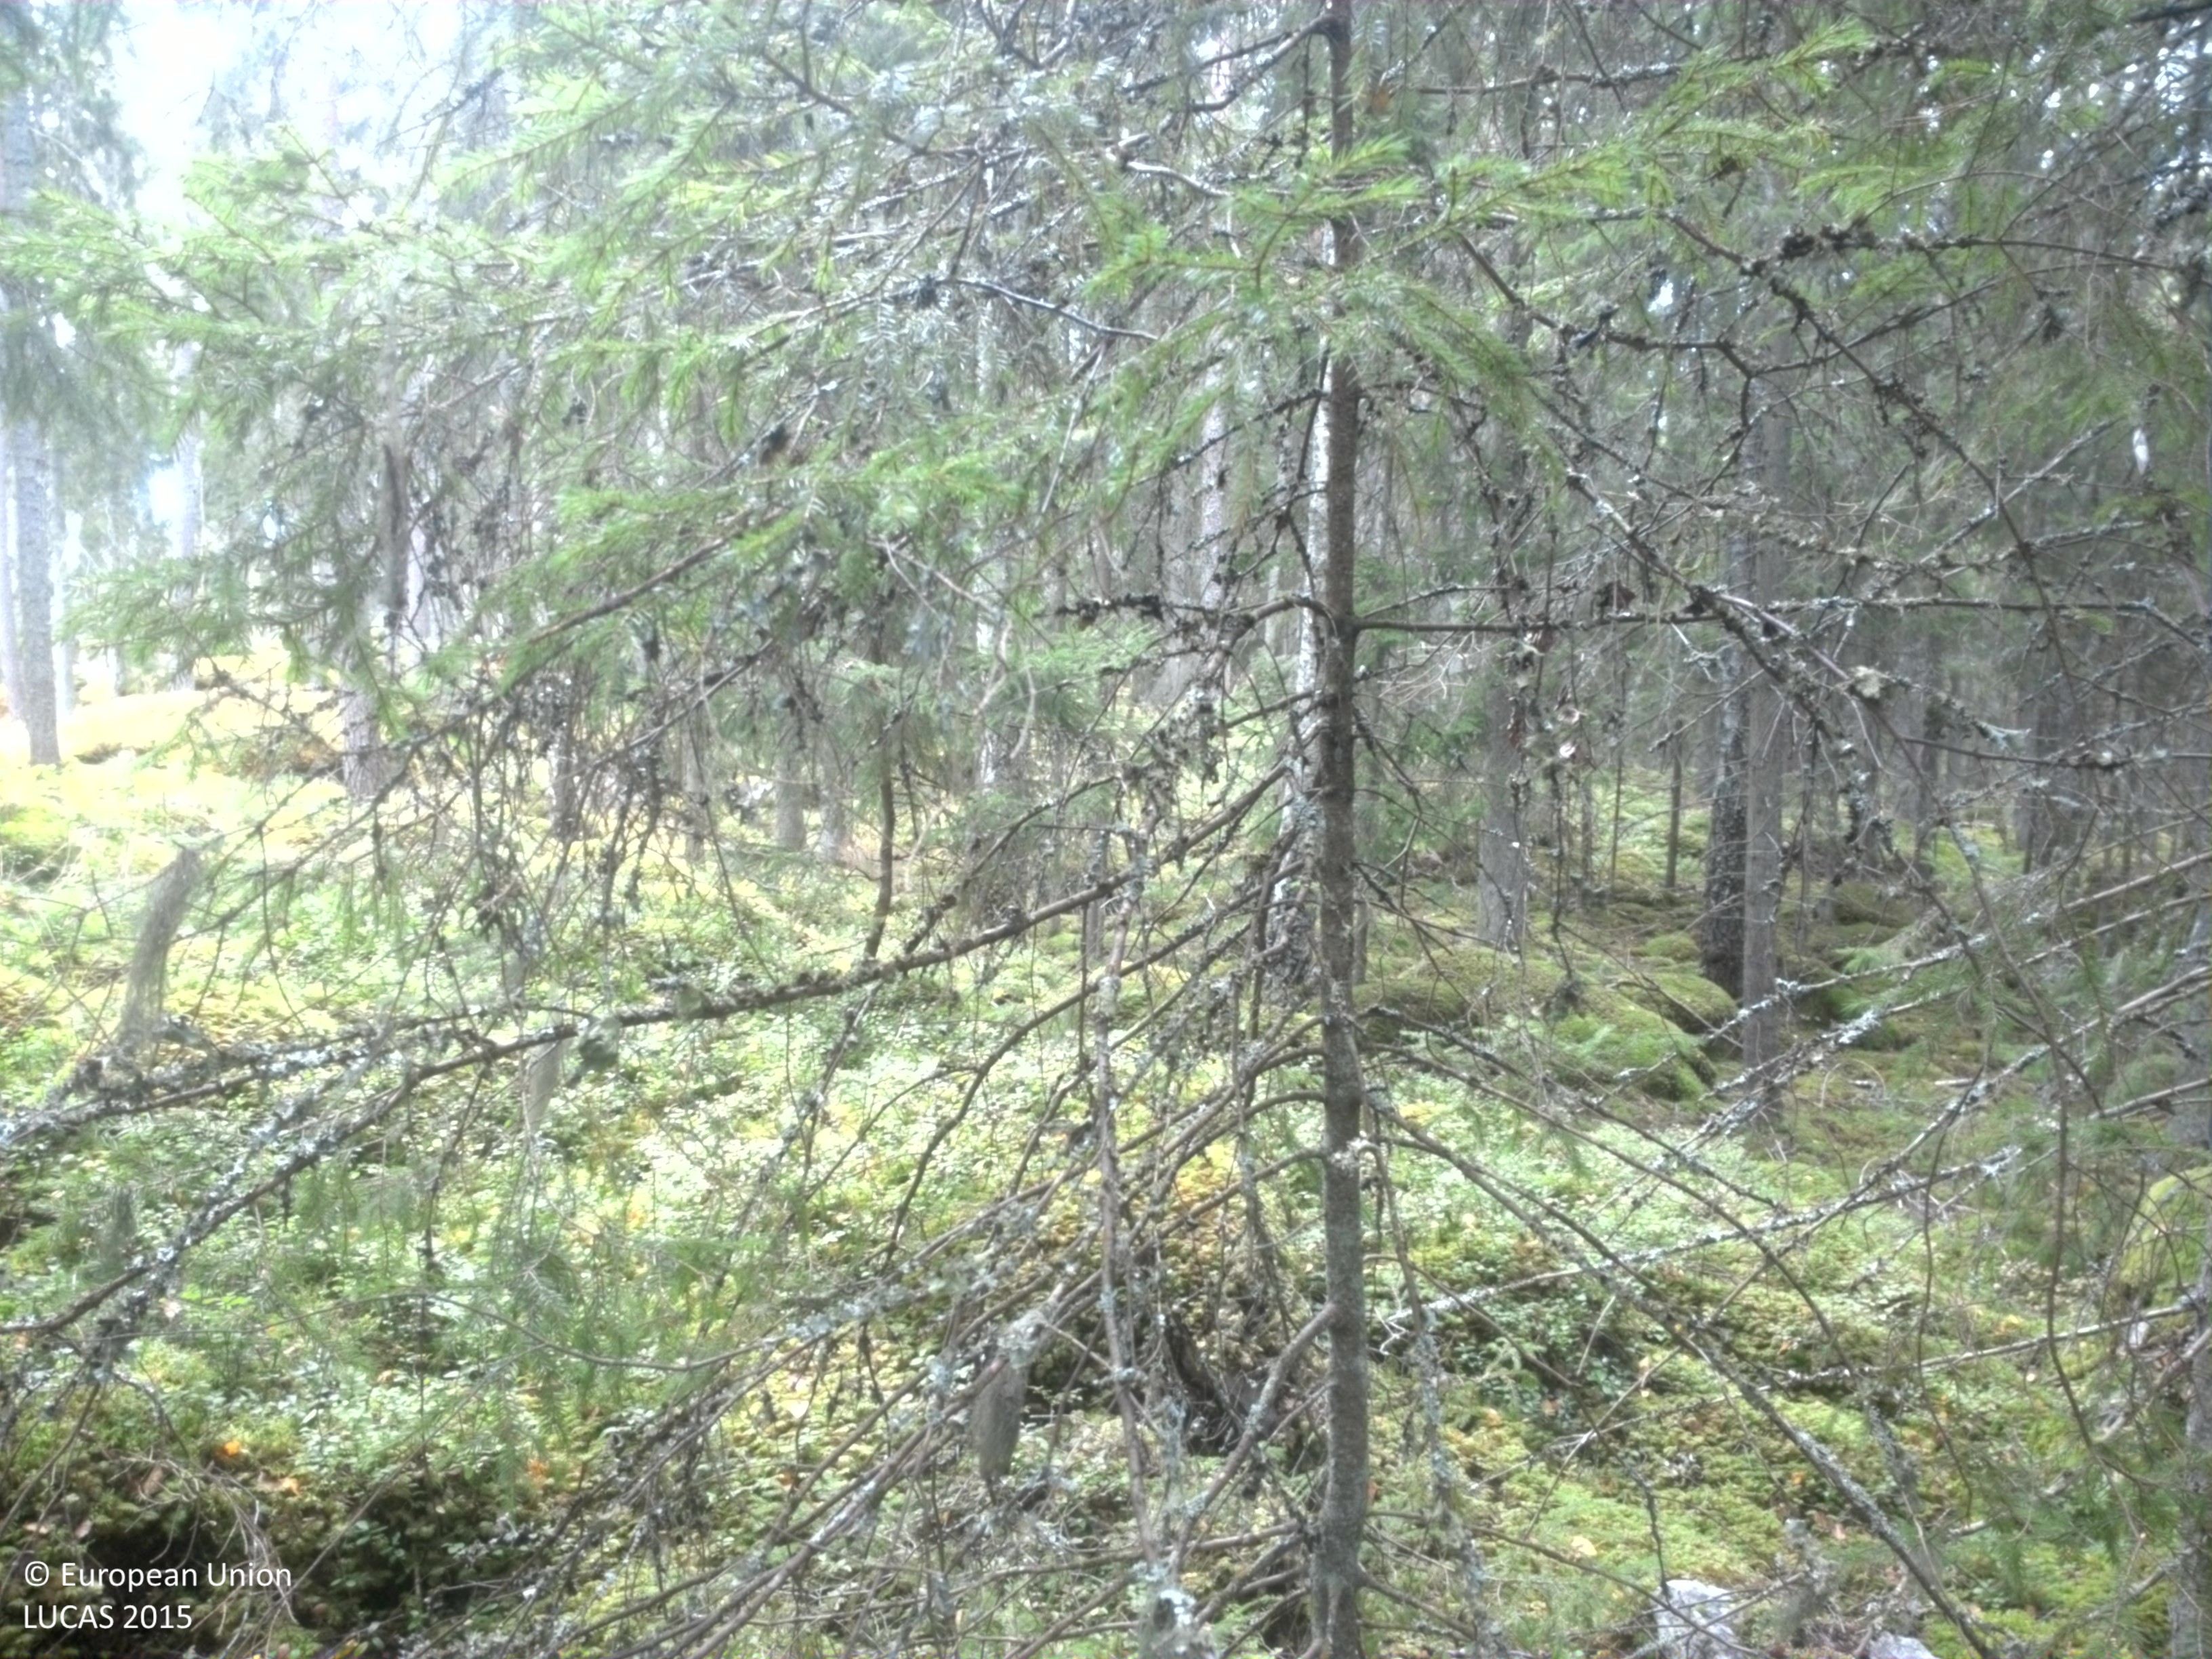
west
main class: Woodland
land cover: Spruce dominated coniferous woodland
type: boreal forest
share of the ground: > 75 %
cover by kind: coniferous forest trees 75 %, lichens and mosses 20 %, shrubs 5 %
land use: Forestry
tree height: > 5 m
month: September
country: SE
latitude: 59.5211
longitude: 15.7711
